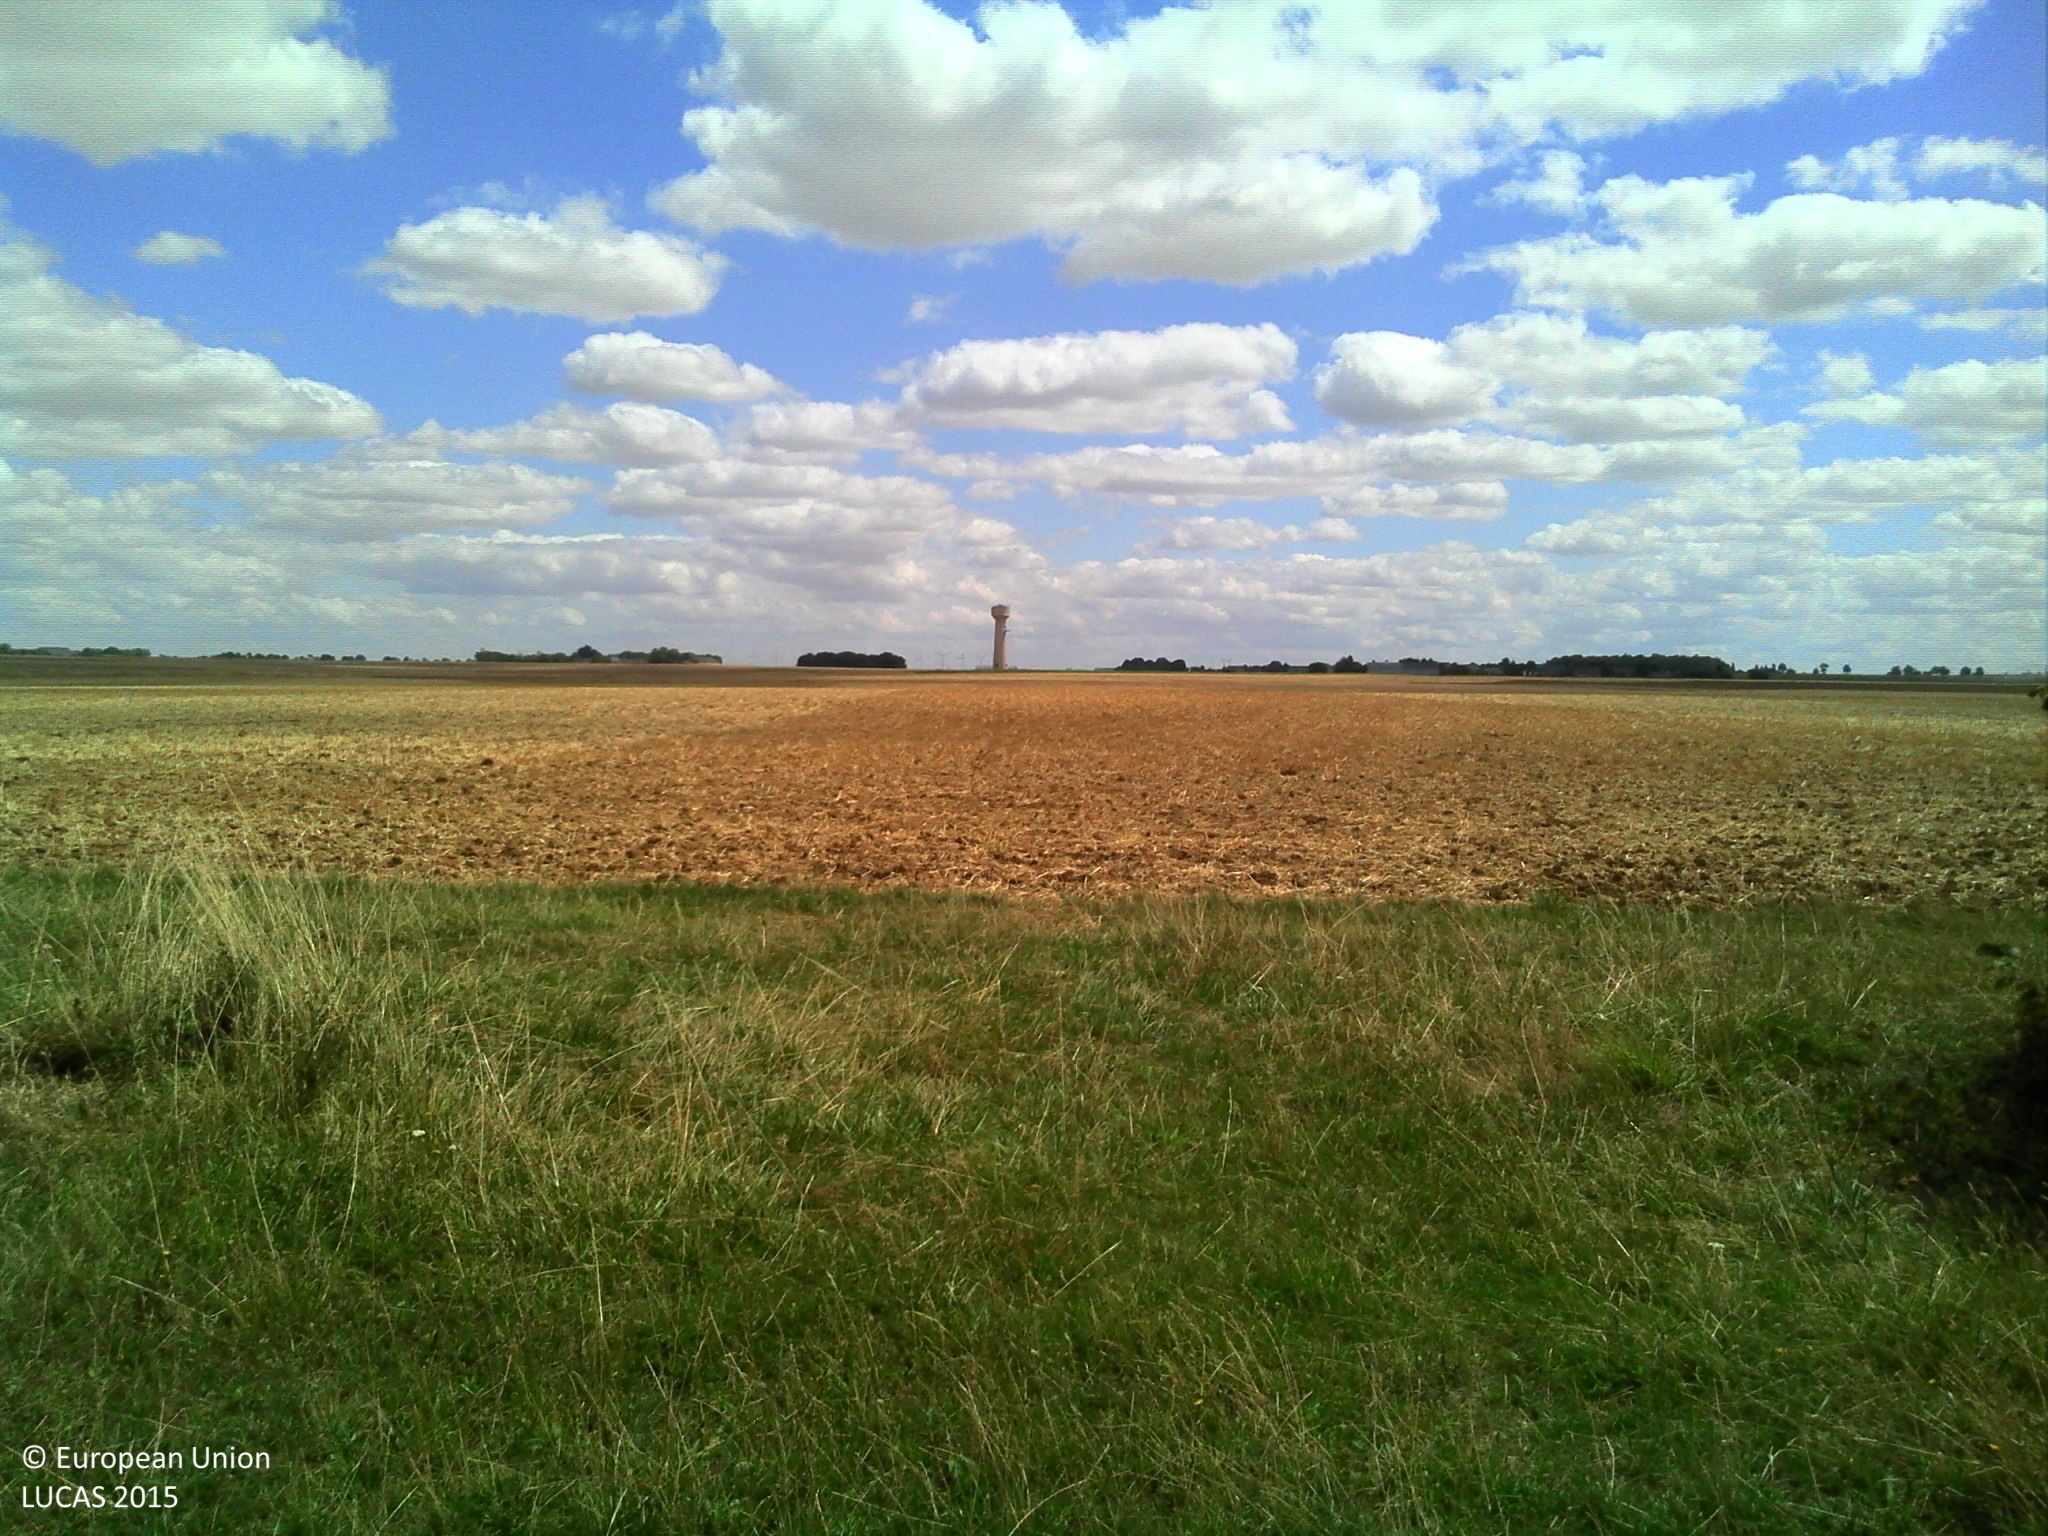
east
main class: Cropland
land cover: Maize
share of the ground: > 75 %
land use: Agriculture (excluding fallow land and kitchen gardens)
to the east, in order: Maize; Tracks; Spontaneously vegetated surfaces; Durum wheat
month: August
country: FR
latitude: 48.2202
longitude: 1.9784
